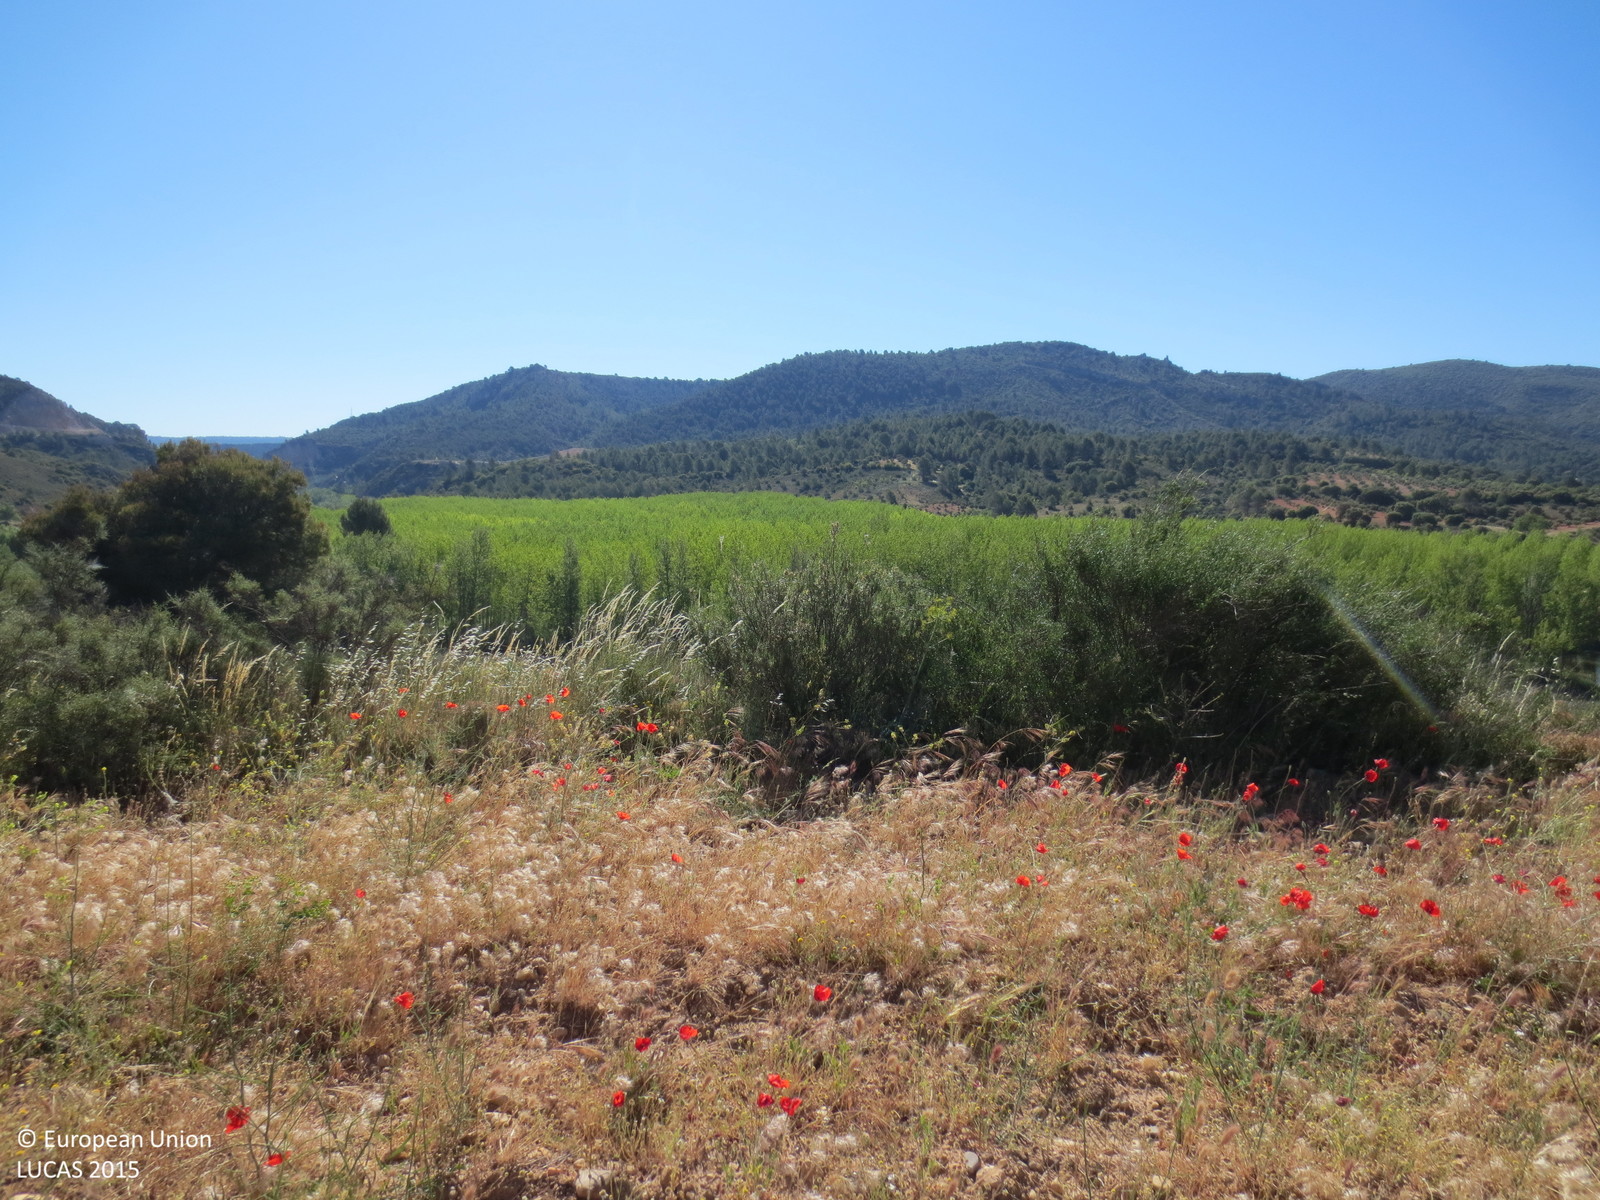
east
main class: Grassland
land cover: Spontaneously vegetated surfaces
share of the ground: 50 - 75 %
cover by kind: herbaceous plants 60 %, unconsolidated bare surface 40 %
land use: Fallow land
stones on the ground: > 50 %
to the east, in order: Spontaneously vegetated surfaces; Shrubland without tree cover; Shrubland with sparse tree cover; Grass margins; Paved roads, cycling and walking lanes; Grass margins; Shrubland with sparse tree cover; Tracks; Shrubland with sparse tree cover; Inland fresh running water; Grassland without tree/shrub cover; Broadleaved woodland
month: May
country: ES
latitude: 40.4885
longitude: -2.7806
